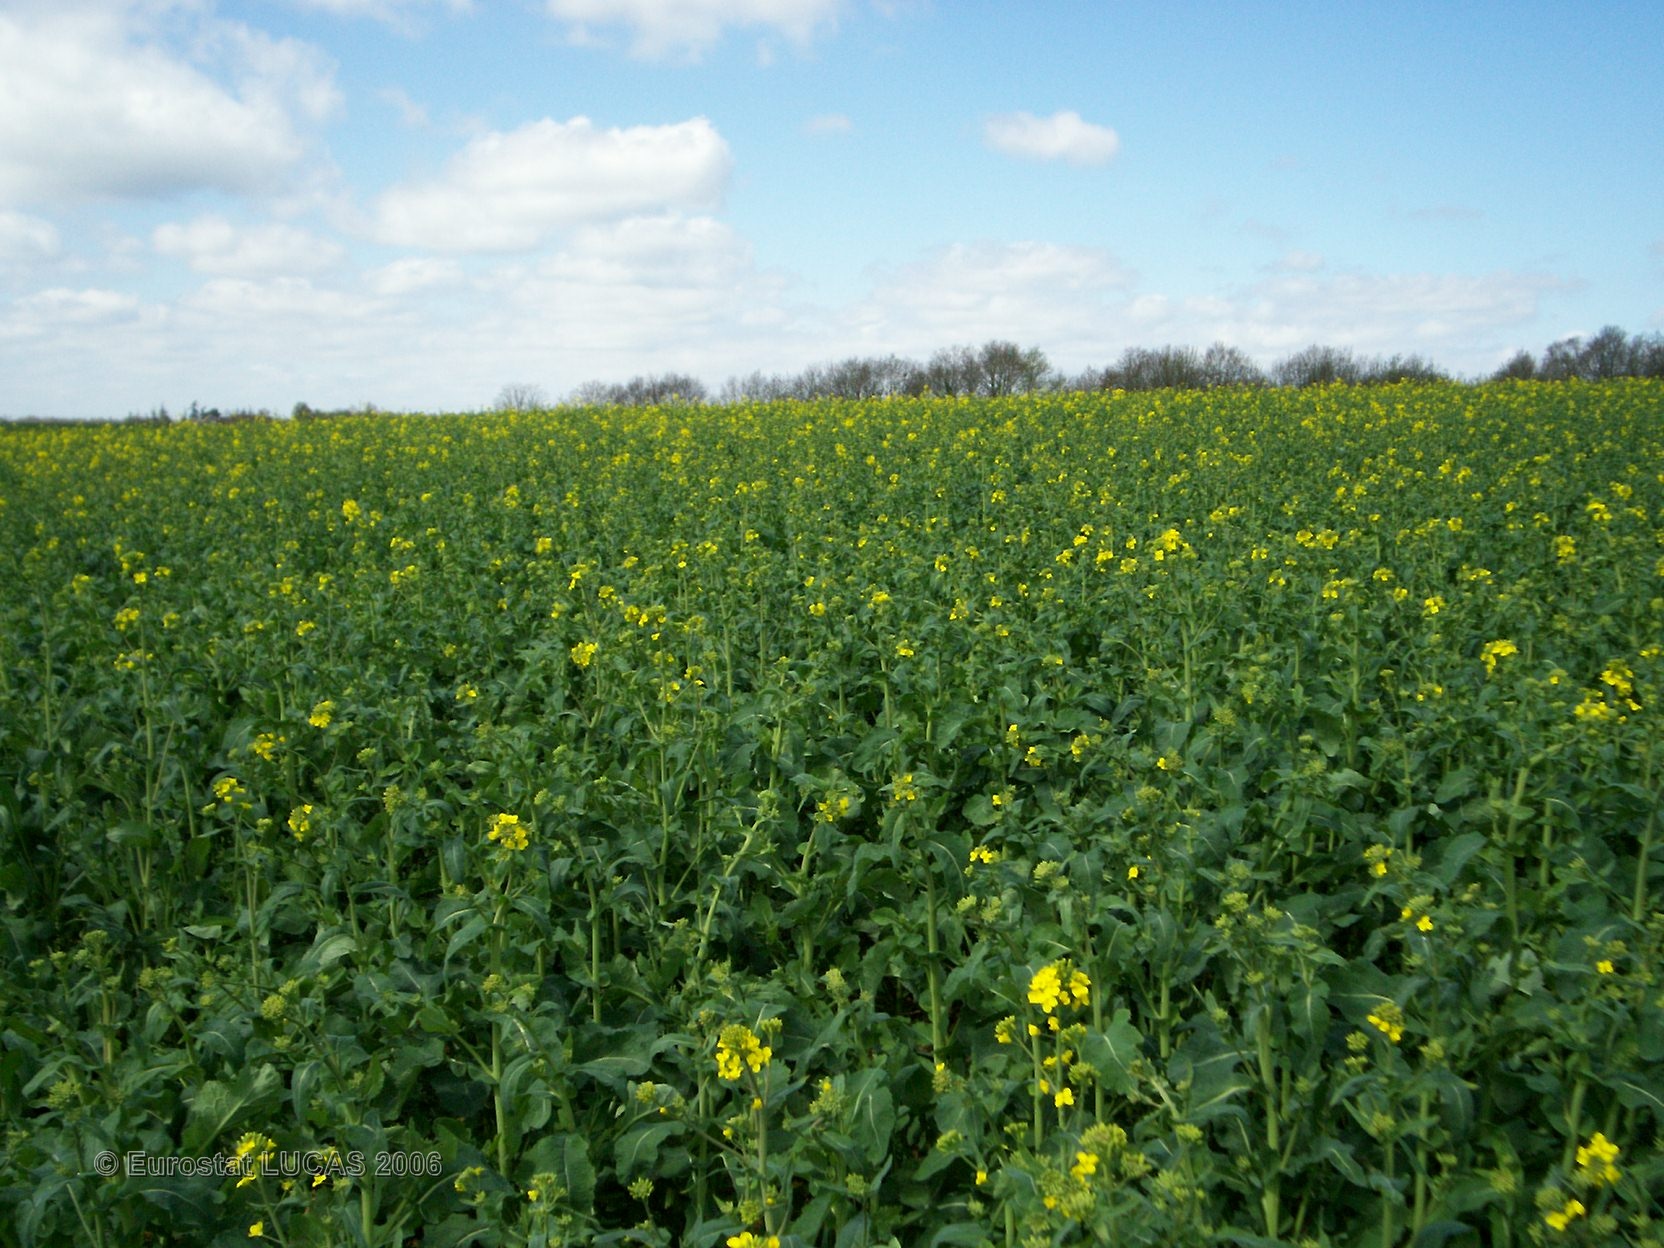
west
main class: Cropland
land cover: Rape and turnip rape
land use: Agriculture (excluding fallow land and kitchen gardens)
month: April
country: FR
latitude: 46.9594
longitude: 0.9033
